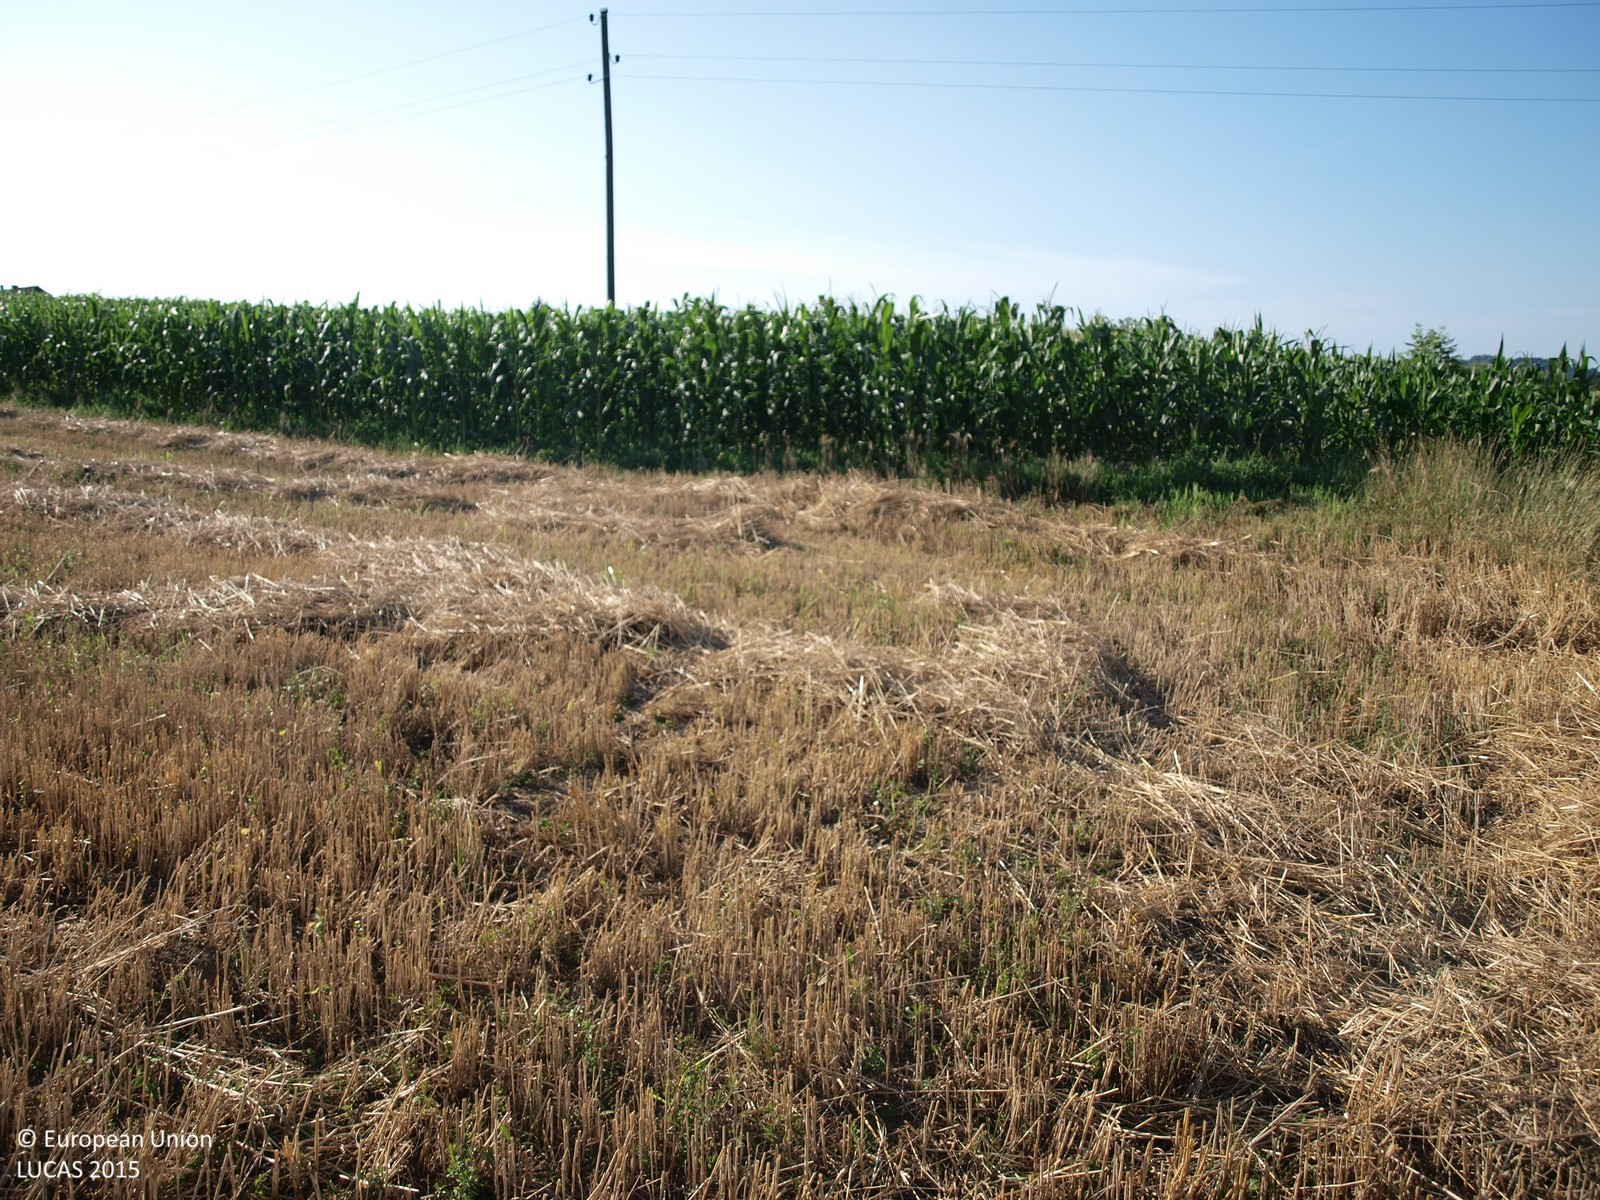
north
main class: Cropland
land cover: Barley
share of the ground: > 75 %
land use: Agriculture (excluding fallow land and kitchen gardens)
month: July
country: HR
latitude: 45.9675
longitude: 15.9733
